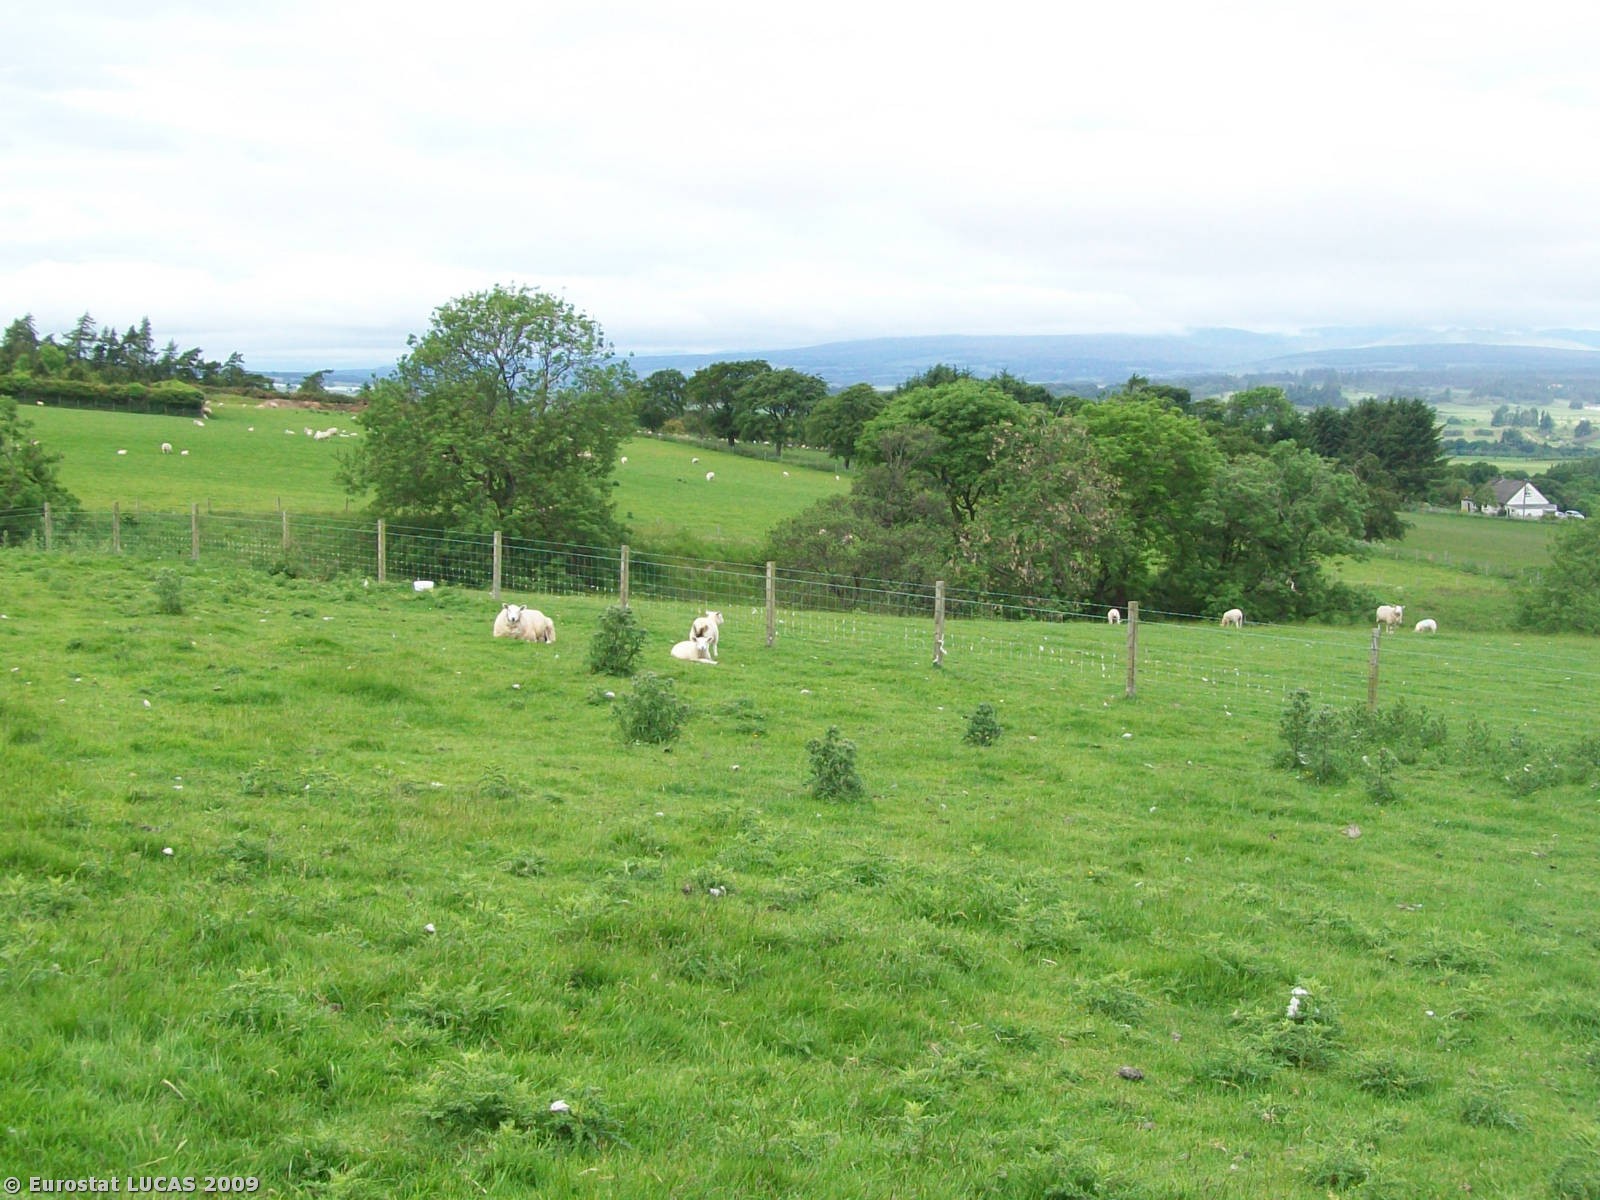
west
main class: Grassland
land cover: Grassland without tree/shrub cover
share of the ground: > 75 %
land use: Agriculture (excluding fallow land and kitchen gardens)
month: June
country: GB
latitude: 56.2711
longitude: -3.6927
